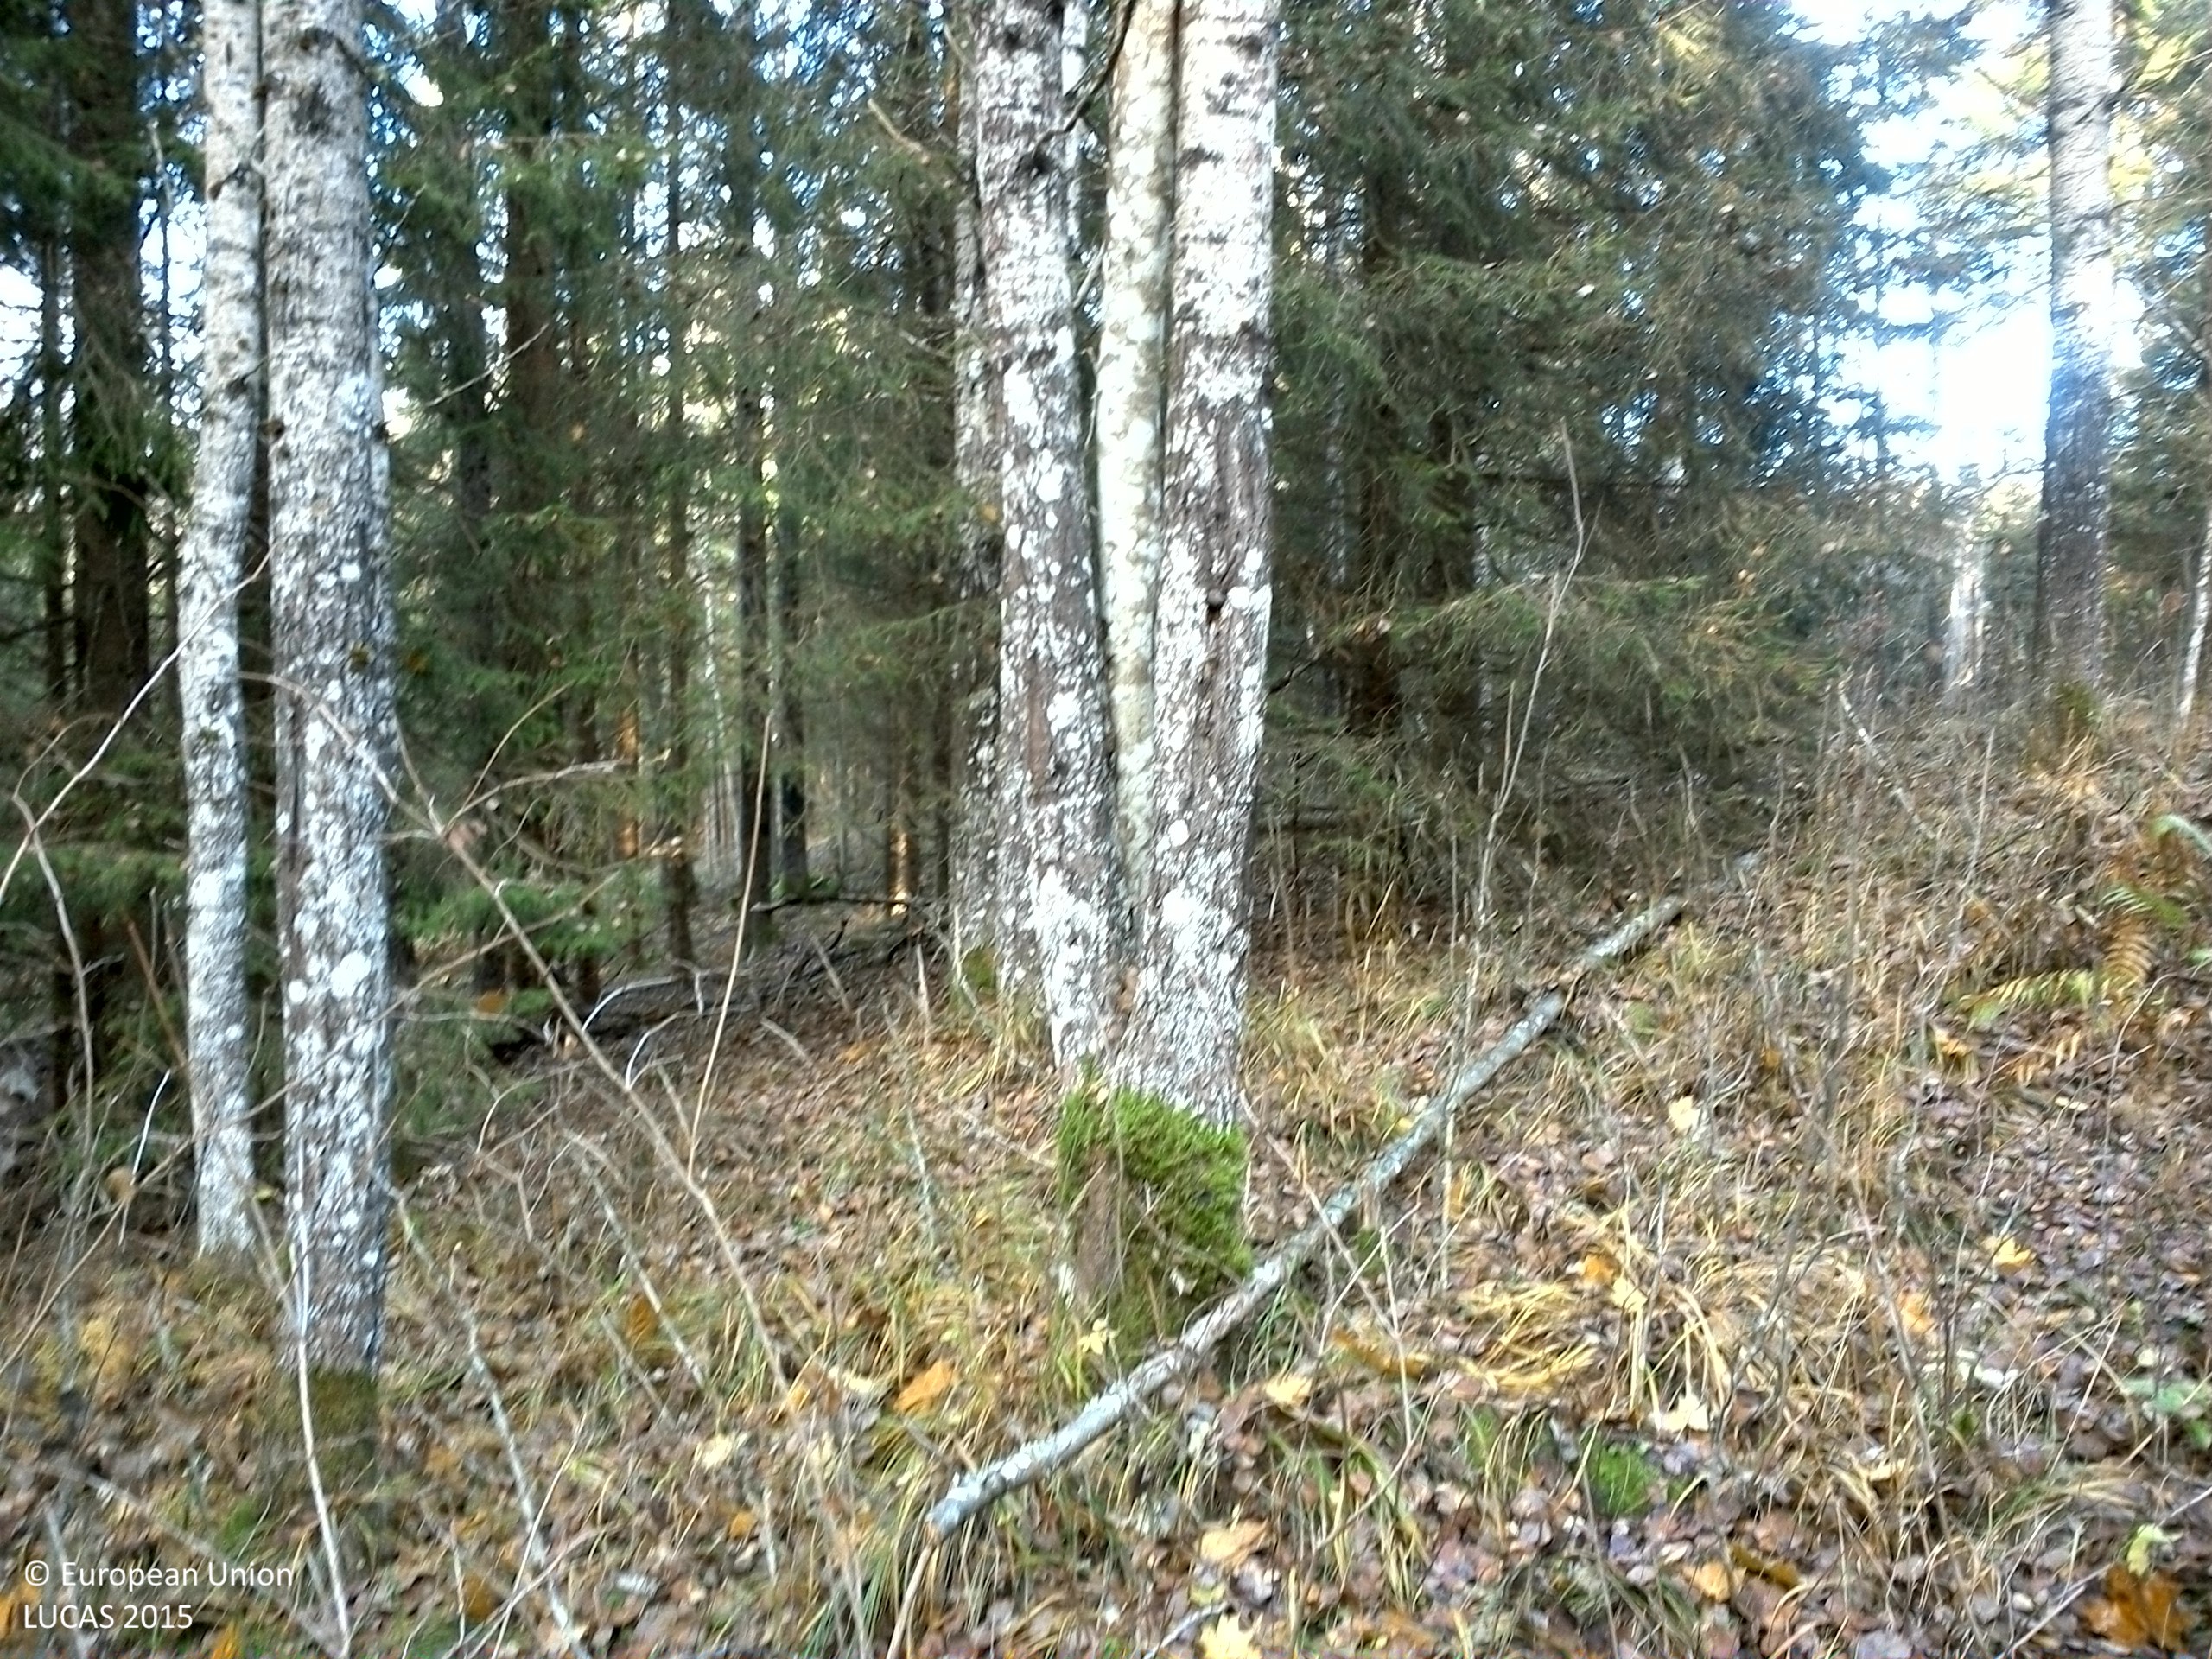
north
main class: Woodland
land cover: Spruce dominated mixed woodland
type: boreal forest
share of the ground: 50 - 75 %
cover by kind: coniferous forest trees 35 %, broadleaved forest trees 35 %, herbaceous plants 20 %, shrubs 10 %
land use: Forestry
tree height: > 5 m
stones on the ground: < 10 %
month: November
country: SE
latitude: 57.9233
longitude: 14.6377
